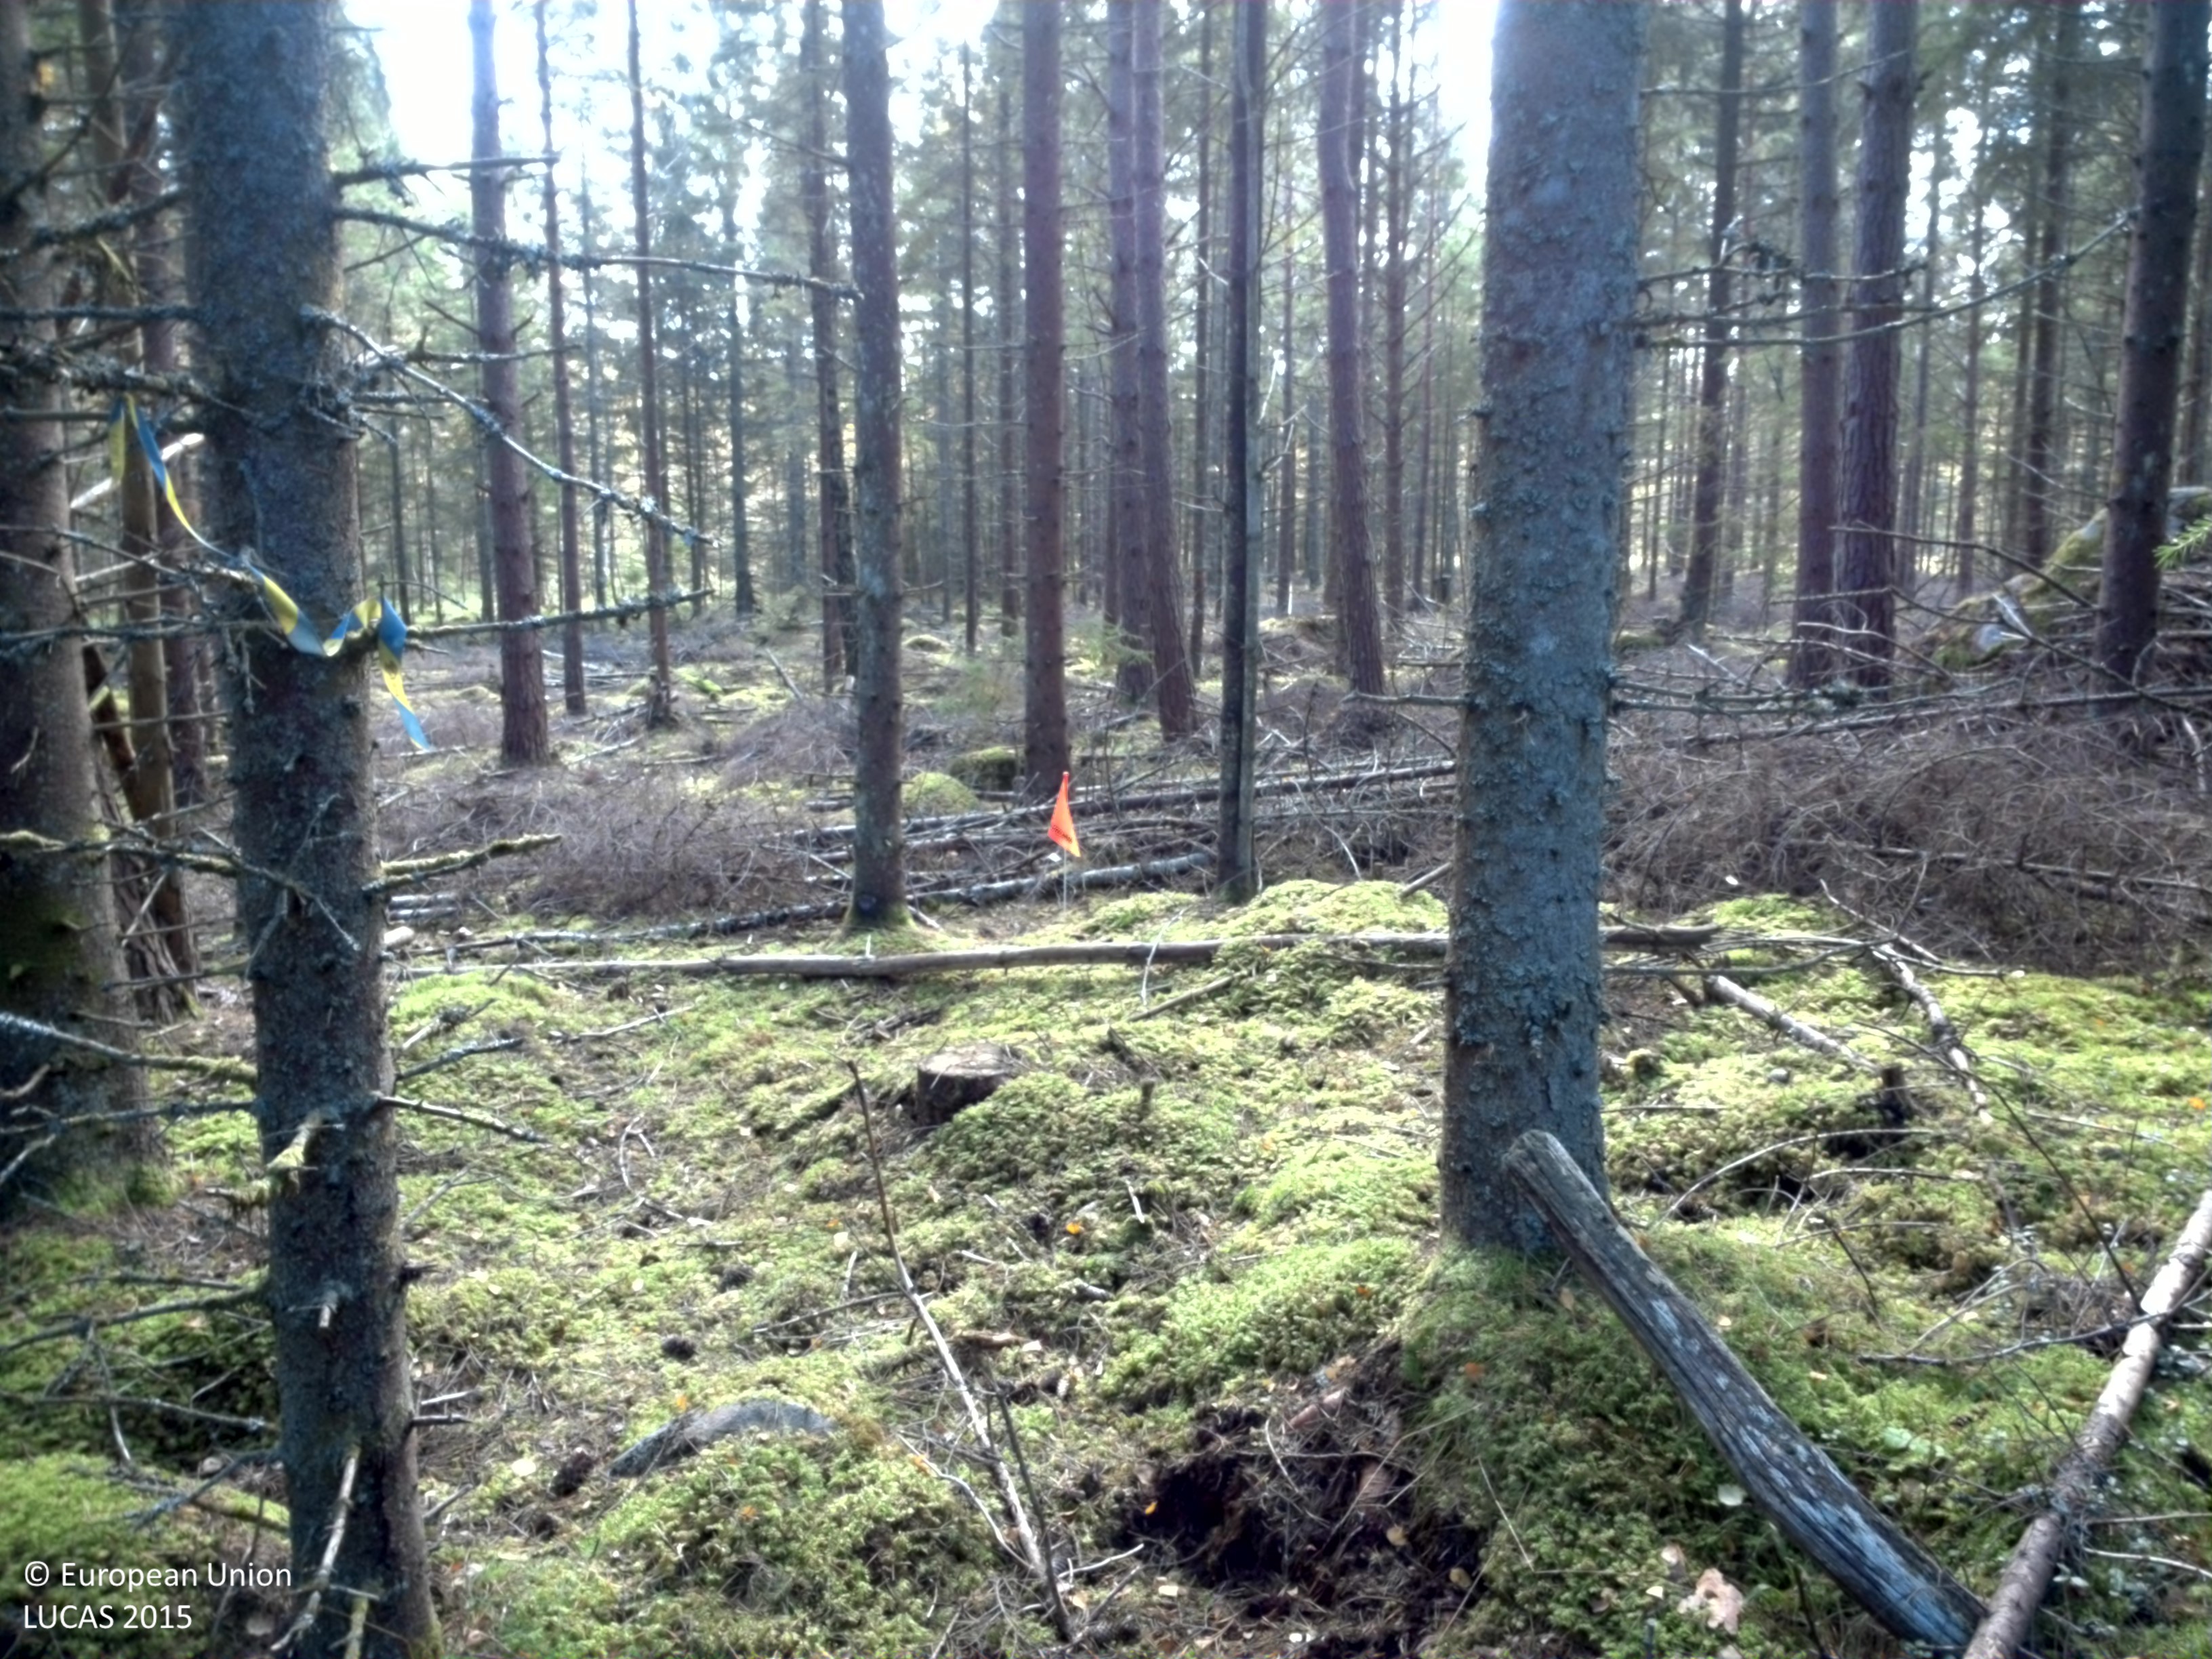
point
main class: Woodland
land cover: Spruce dominated coniferous woodland
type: boreal forest
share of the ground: 50 - 75 %
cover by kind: coniferous forest trees 65 %, lichens and mosses 30 %, unconsolidated bare surface 5 %
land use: Forestry
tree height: > 5 m
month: September
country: SE
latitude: 57.9632
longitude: 13.2908
